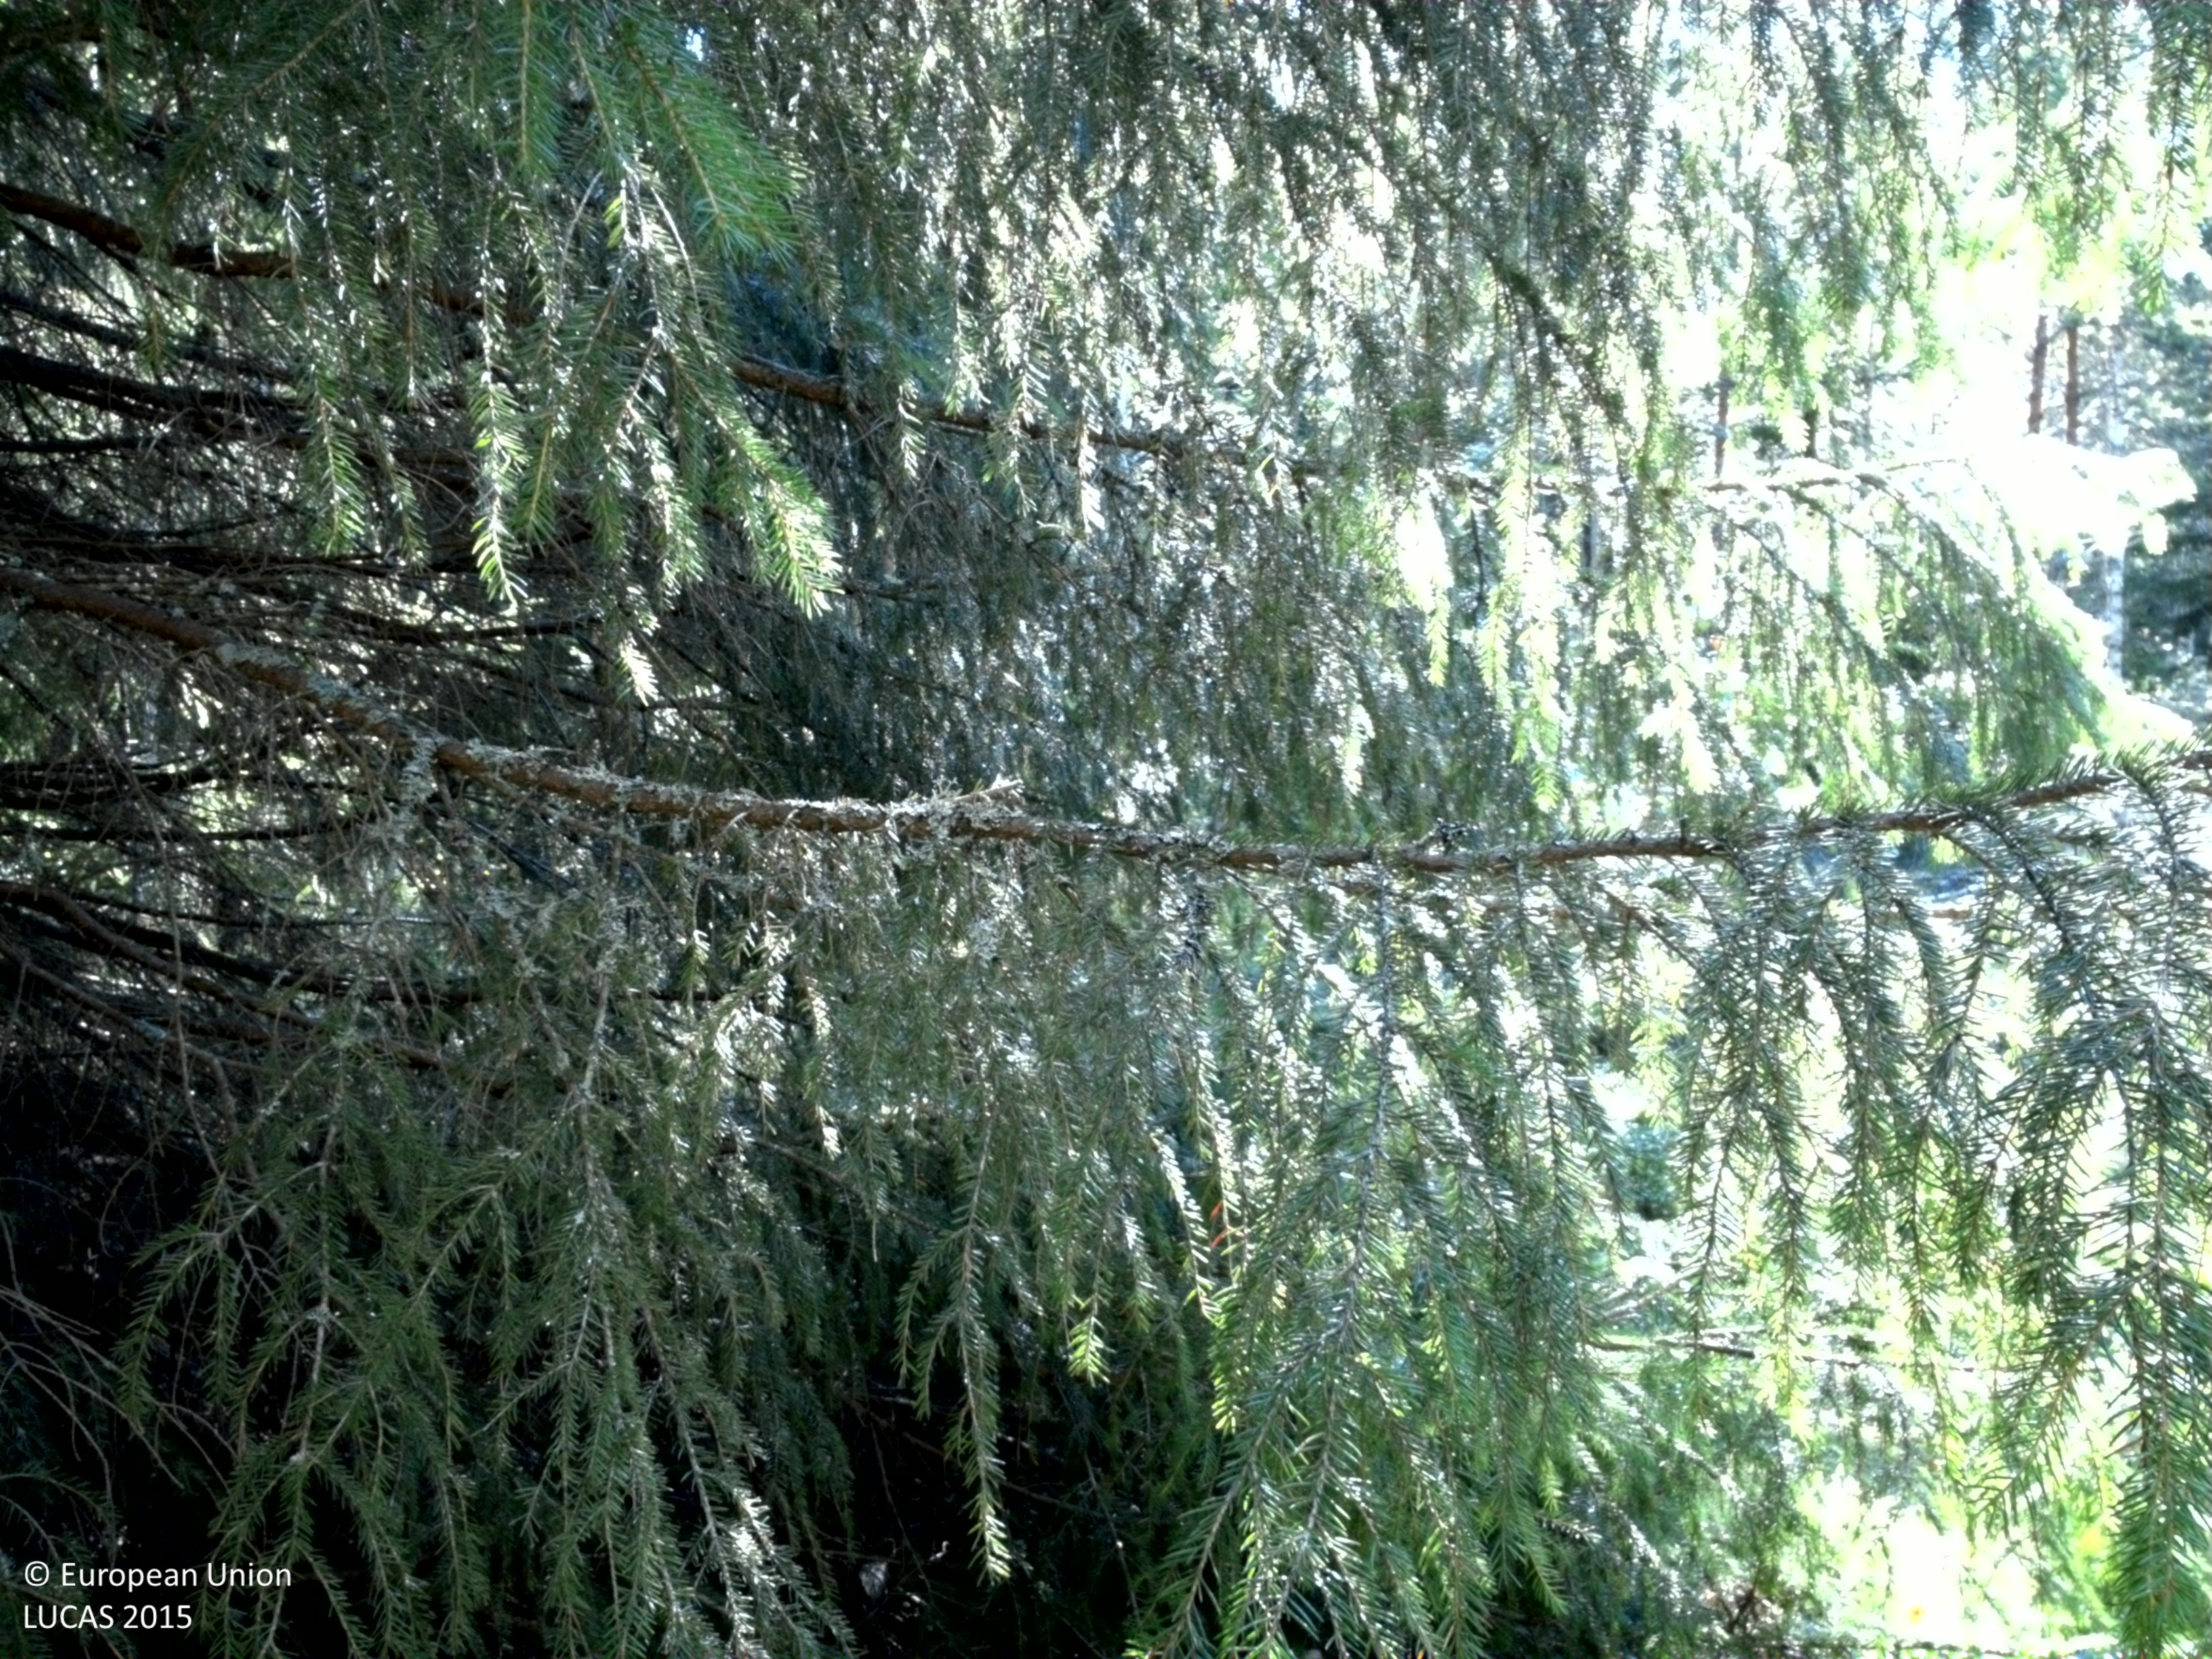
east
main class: Woodland
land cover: Spruce dominated mixed woodland
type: boreal forest
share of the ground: 50 - 75 %
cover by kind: coniferous forest trees 45 %, broadleaved forest trees 30 %, lichens and mosses 15 %, herbaceous plants 10 %
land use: Forestry
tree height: > 5 m
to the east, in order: Spruce dominated mixed woodland; Pine dominated coniferous woodland; Tracks; Broadleaved woodland; Spruce dominated coniferous woodland; Fences; Spruce dominated coniferous woodland
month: August
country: SE
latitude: 59.7669
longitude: 17.7762
